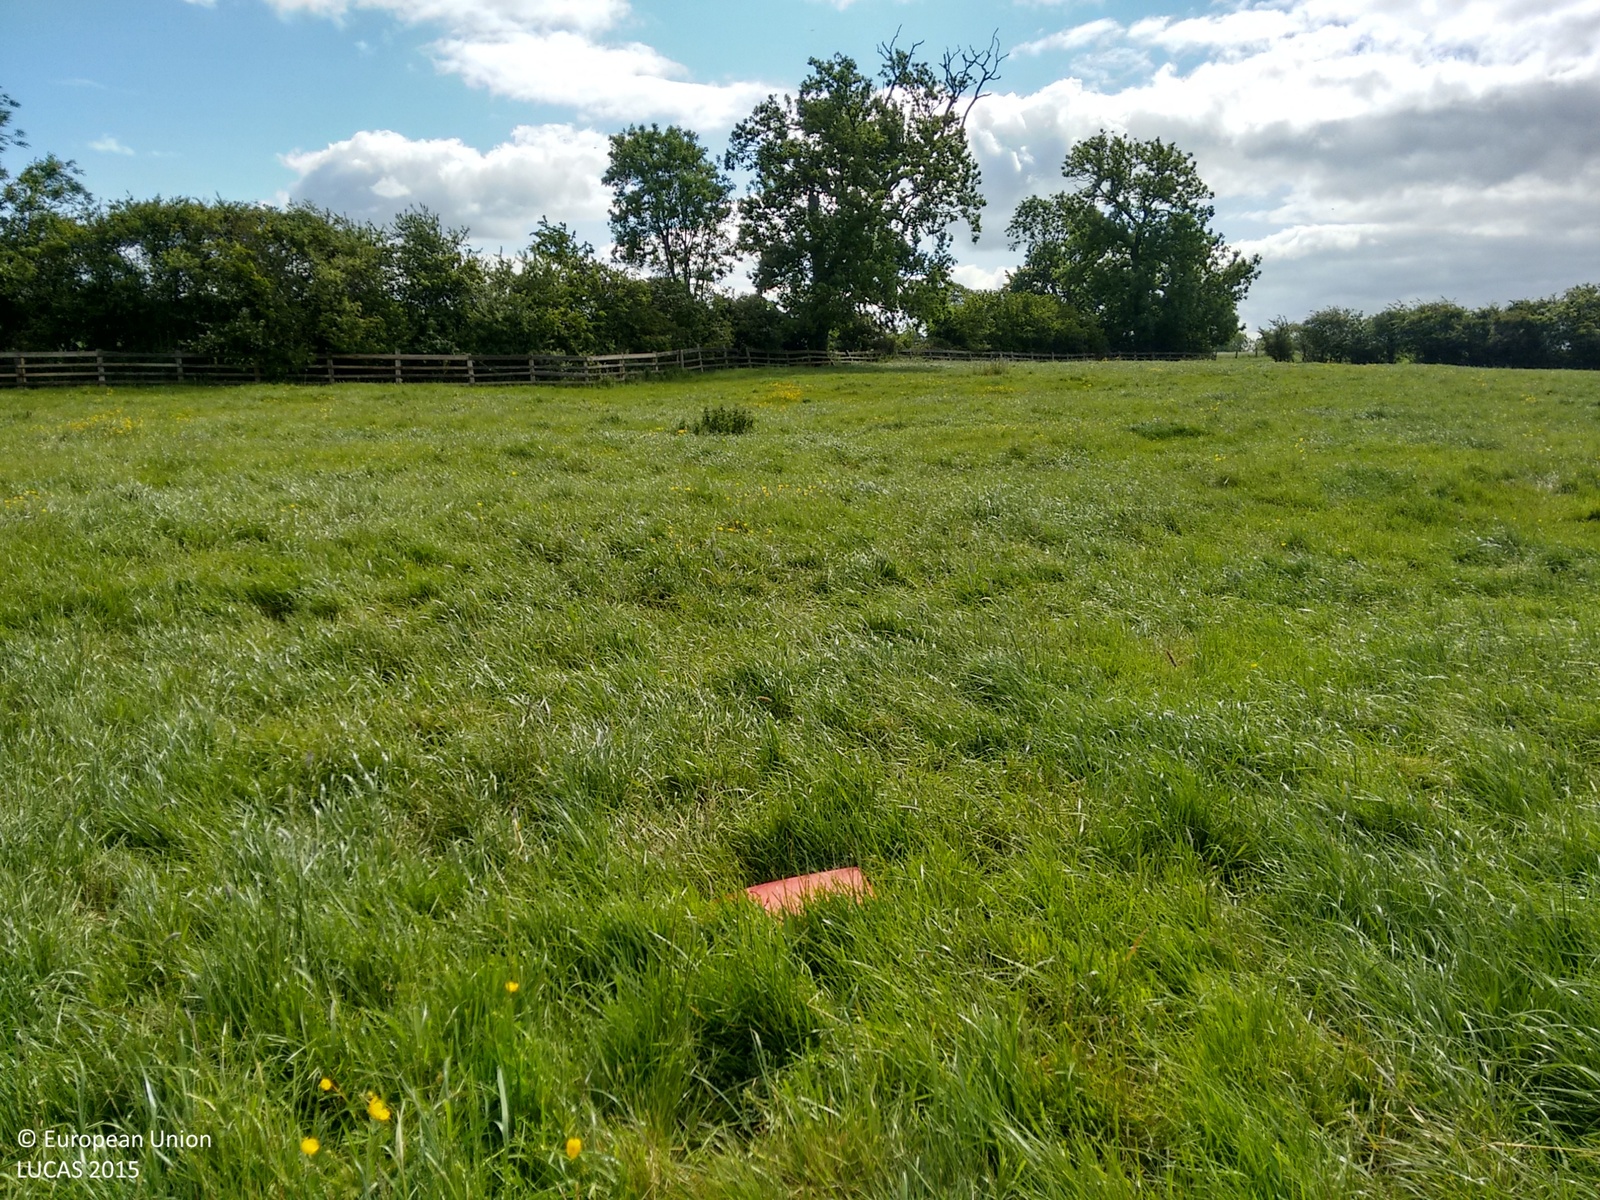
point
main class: Grassland
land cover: Grassland without tree/shrub cover
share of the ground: > 75 %
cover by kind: herbaceous plants 100 %
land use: Agriculture (excluding fallow land and kitchen gardens)
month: June
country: GB
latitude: 52.5182
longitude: -1.3819
